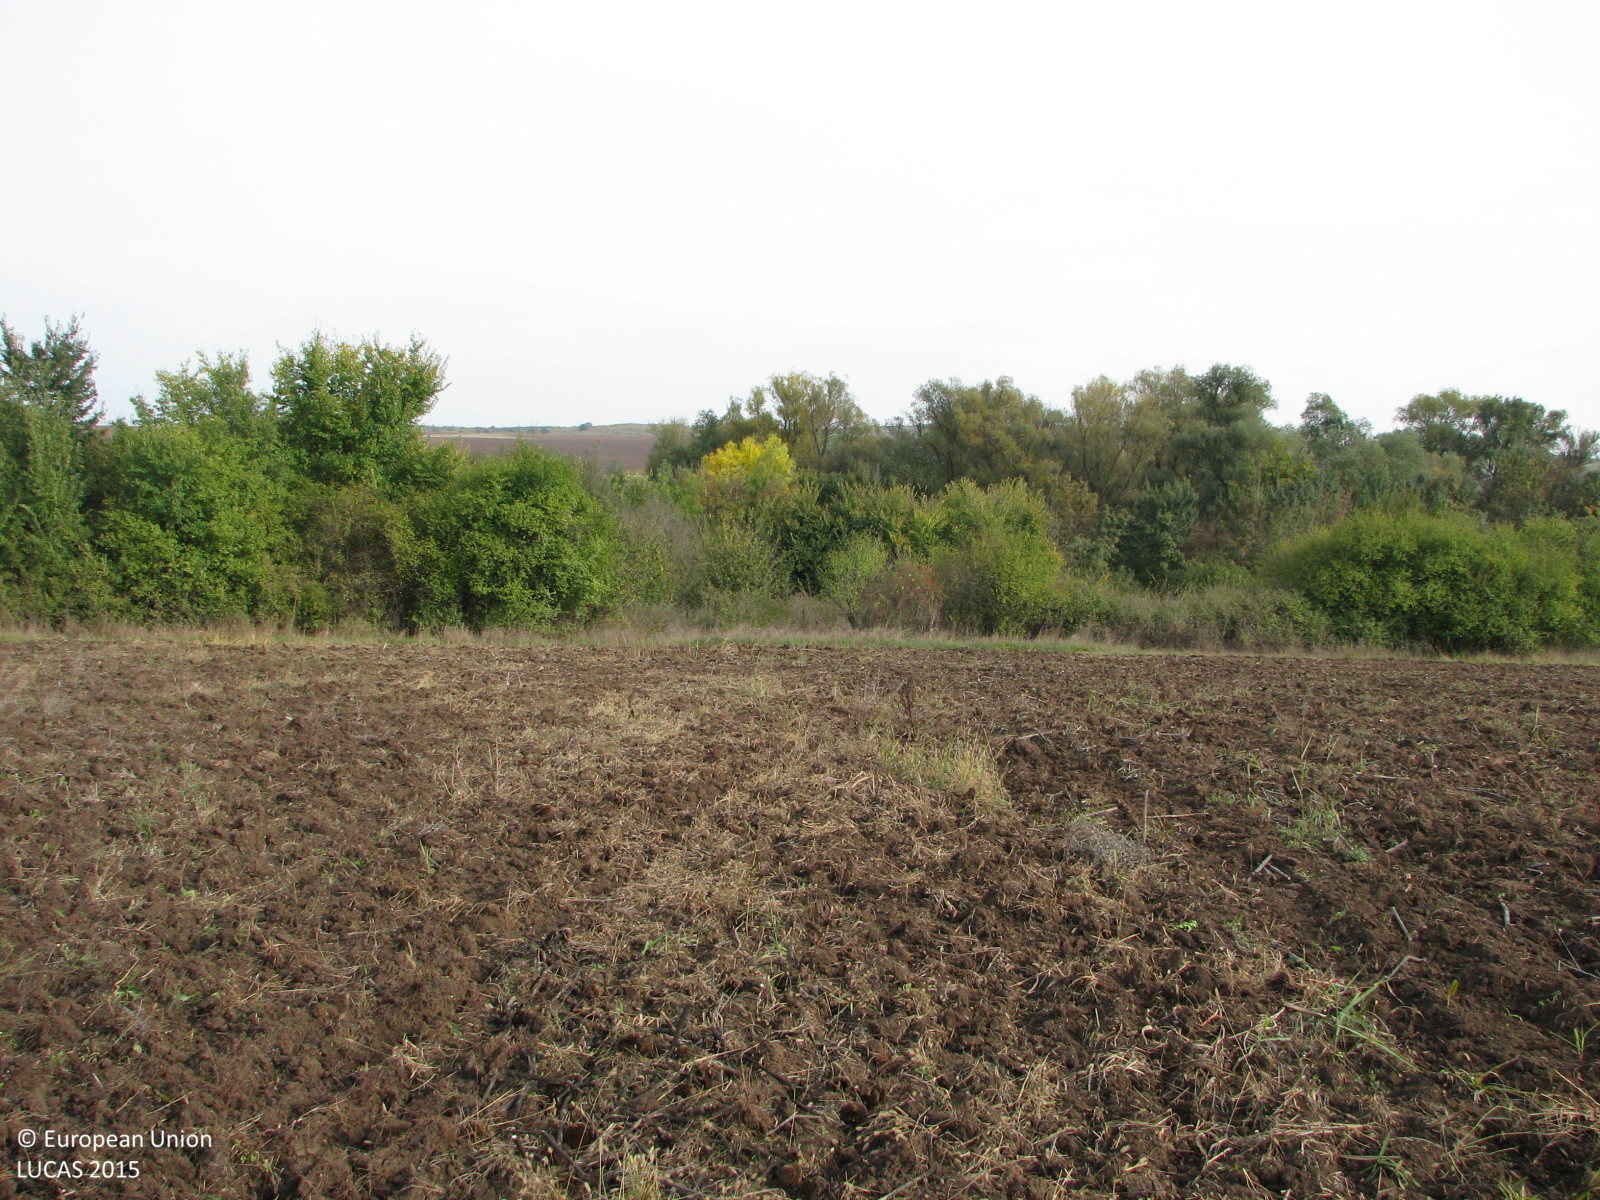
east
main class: Cropland
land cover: Sunflower
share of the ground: < 10 %
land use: Agriculture (excluding fallow land and kitchen gardens)
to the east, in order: Sunflower; Broadleaved woodland; Other bare soil; Broadleaved woodland; Inland fresh water bodies; Broadleaved woodland; Arable land (only in case pi)
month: October
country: BG
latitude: 42.5018
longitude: 26.7328
